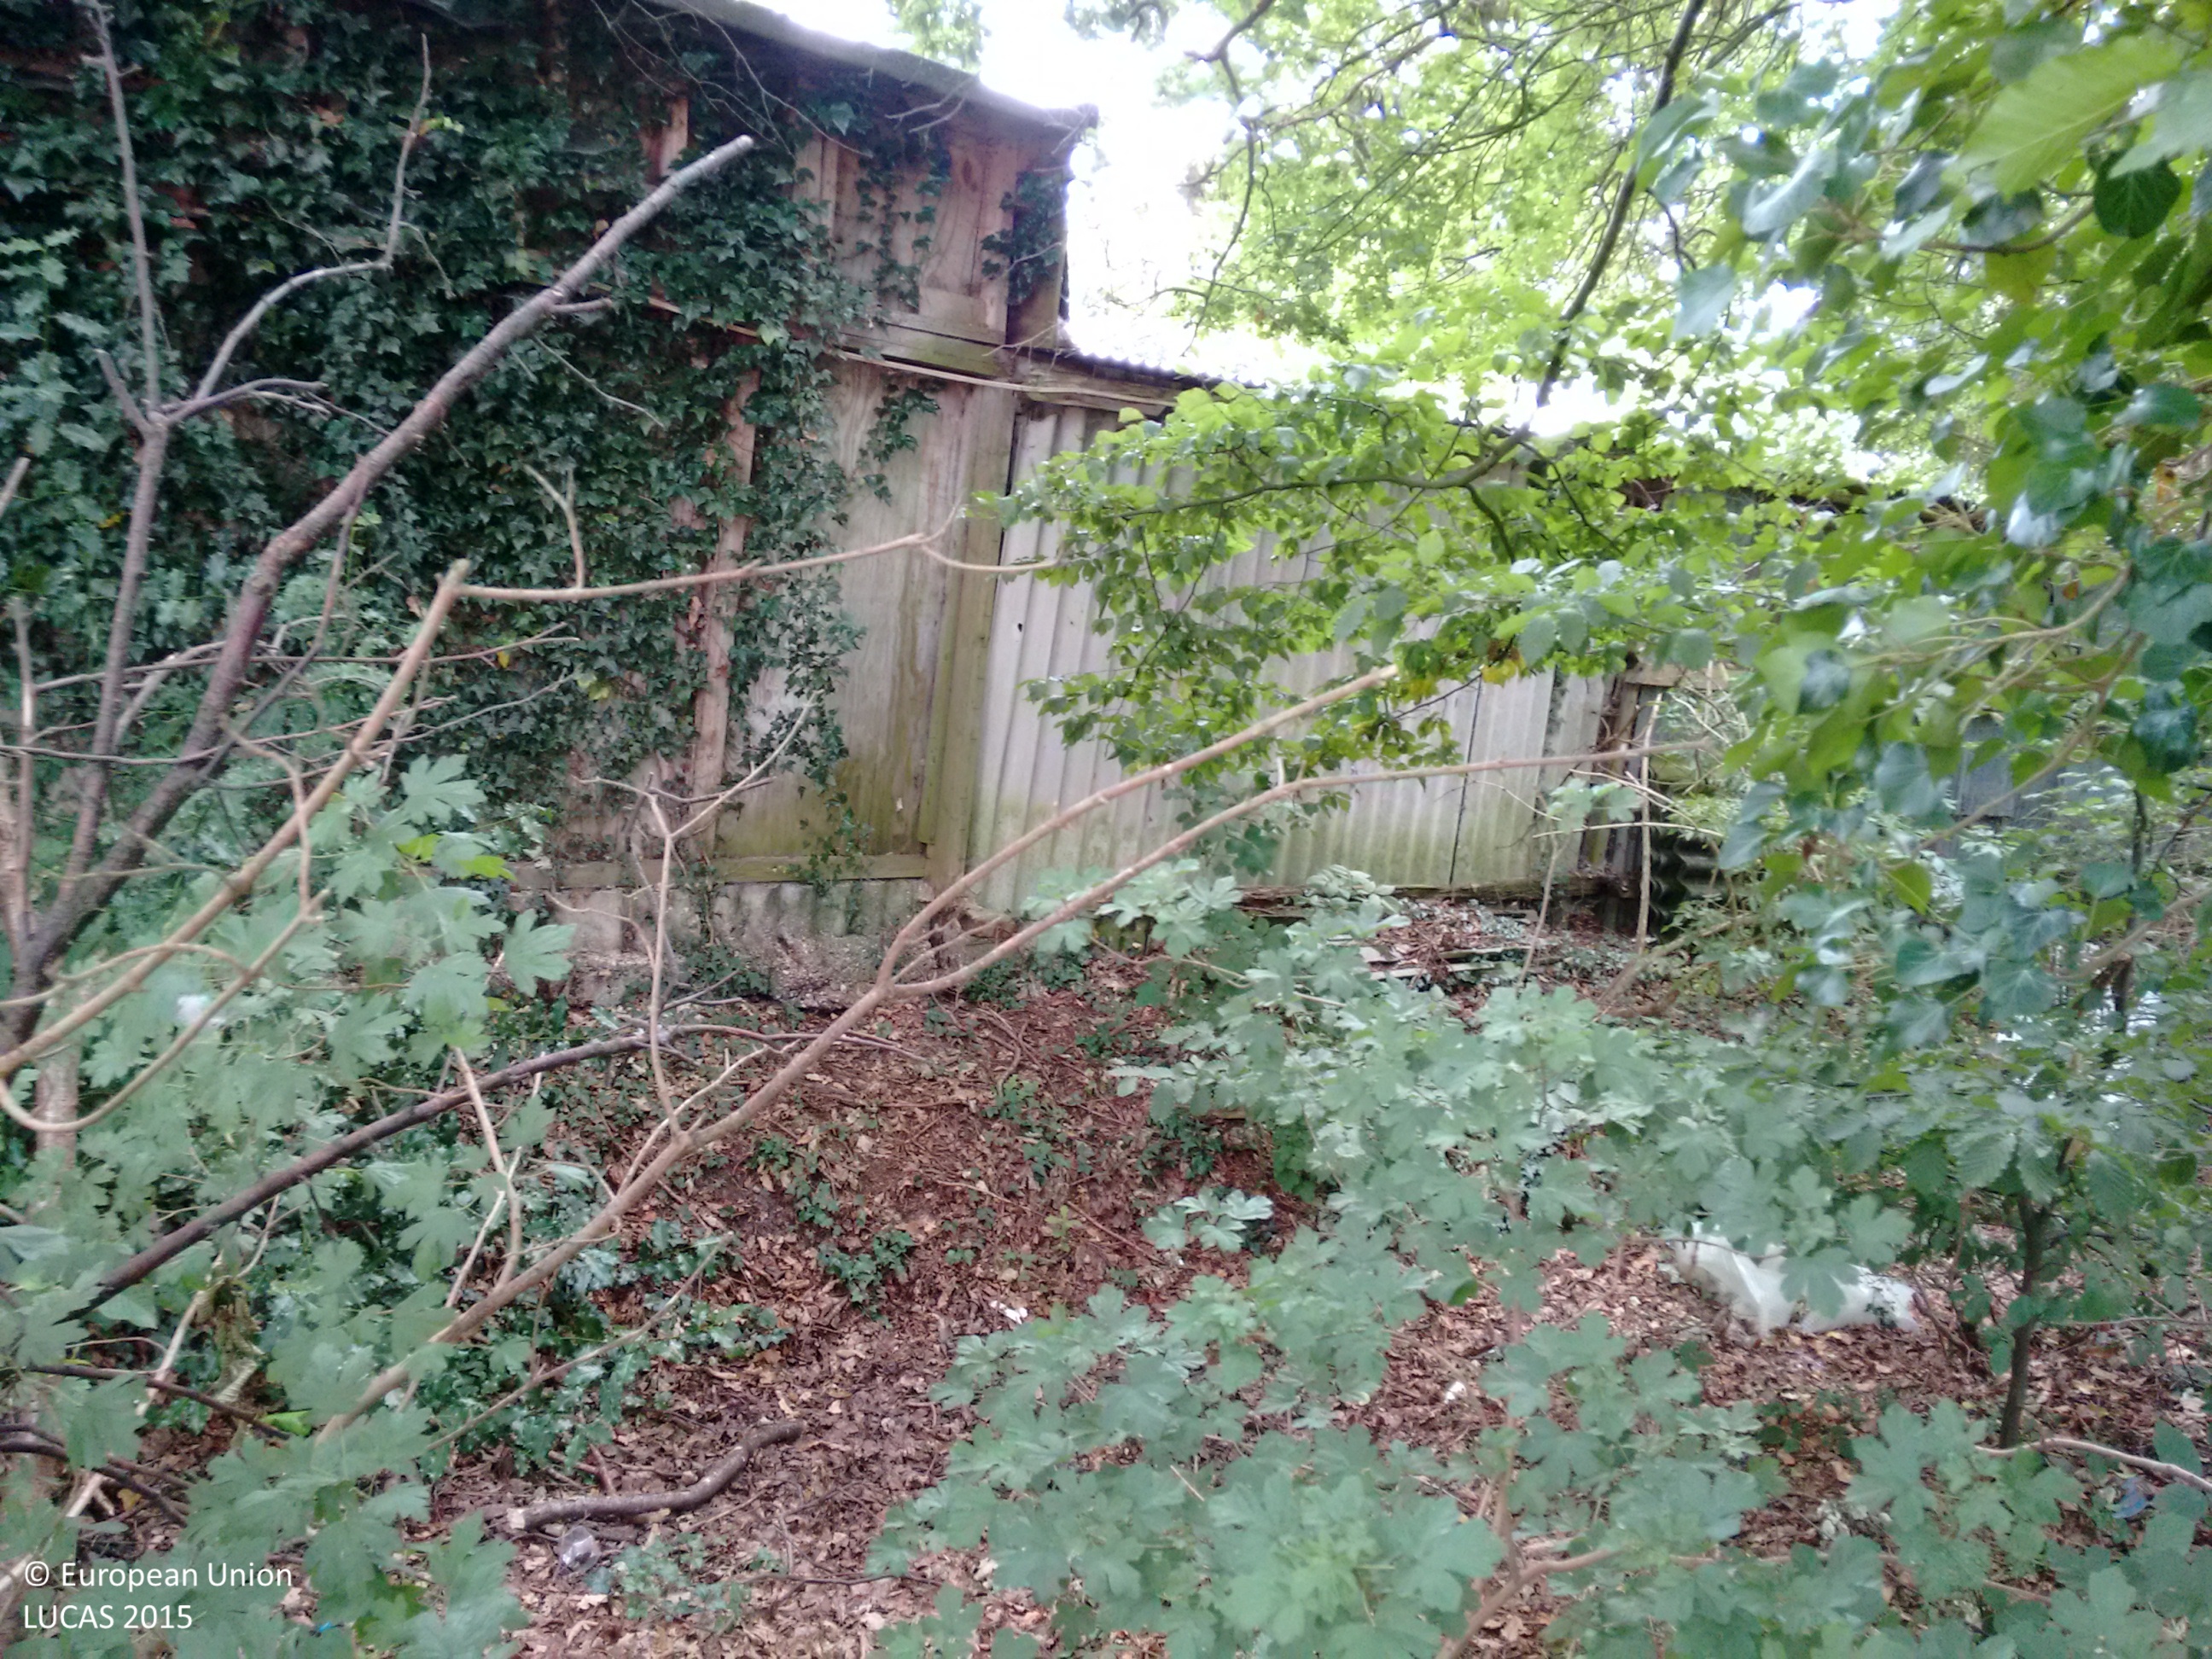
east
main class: Woodland
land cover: Broadleaved woodland
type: mesophytic deciduous forest
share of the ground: 50 - 75 %
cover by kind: broadleaved forest trees 60 %, herbaceous plants 30 %, shrubs 10 %
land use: Semi-natural and natural areas not in use
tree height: > 5 m
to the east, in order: Broadleaved woodland; Ditches and canals; Artificial constructions in urban areas; Abandoned hedges; Grassland without tree/shrub cover; Lines of trees; Artificial constructions in urban areas
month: July
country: GB
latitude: 51.5916
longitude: -0.4158
